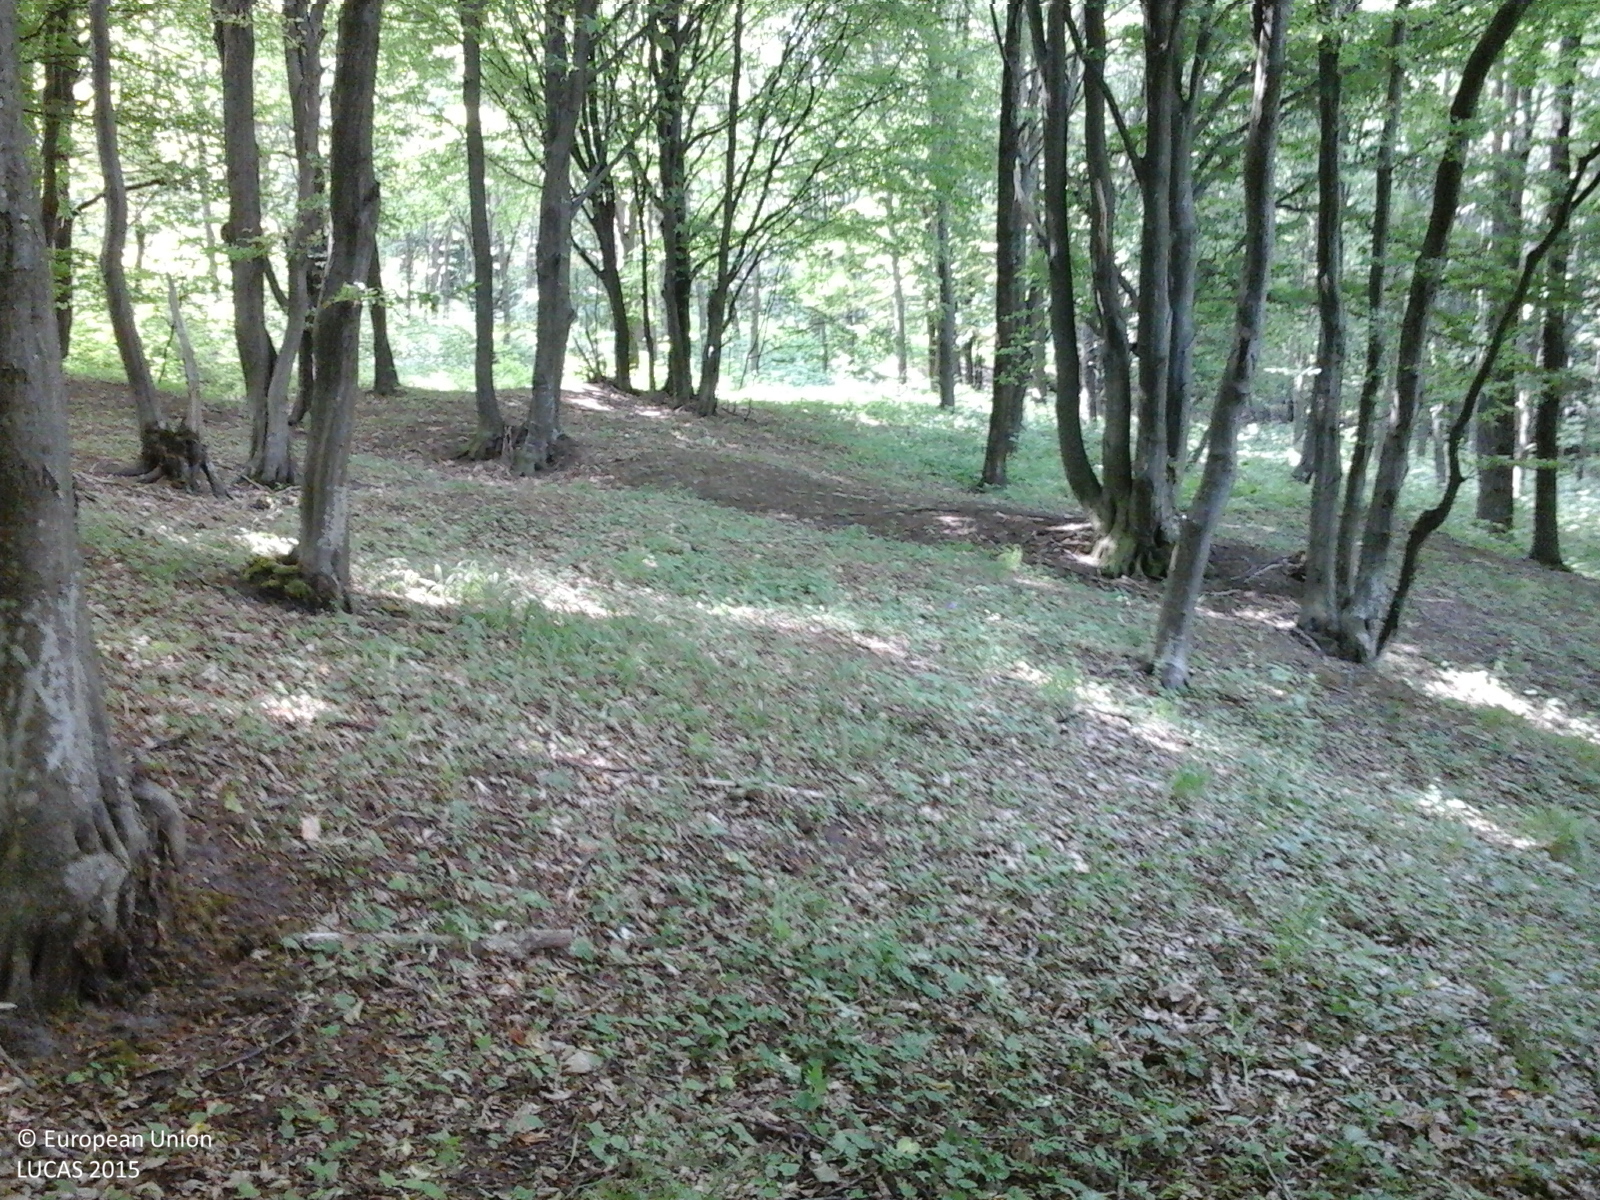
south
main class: Woodland
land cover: Broadleaved woodland
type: beech forest
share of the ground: > 75 %
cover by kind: broadleaved forest trees 100 %
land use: Forestry
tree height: > 5 m
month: June
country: RO
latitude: 47.4030
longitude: 26.7789
